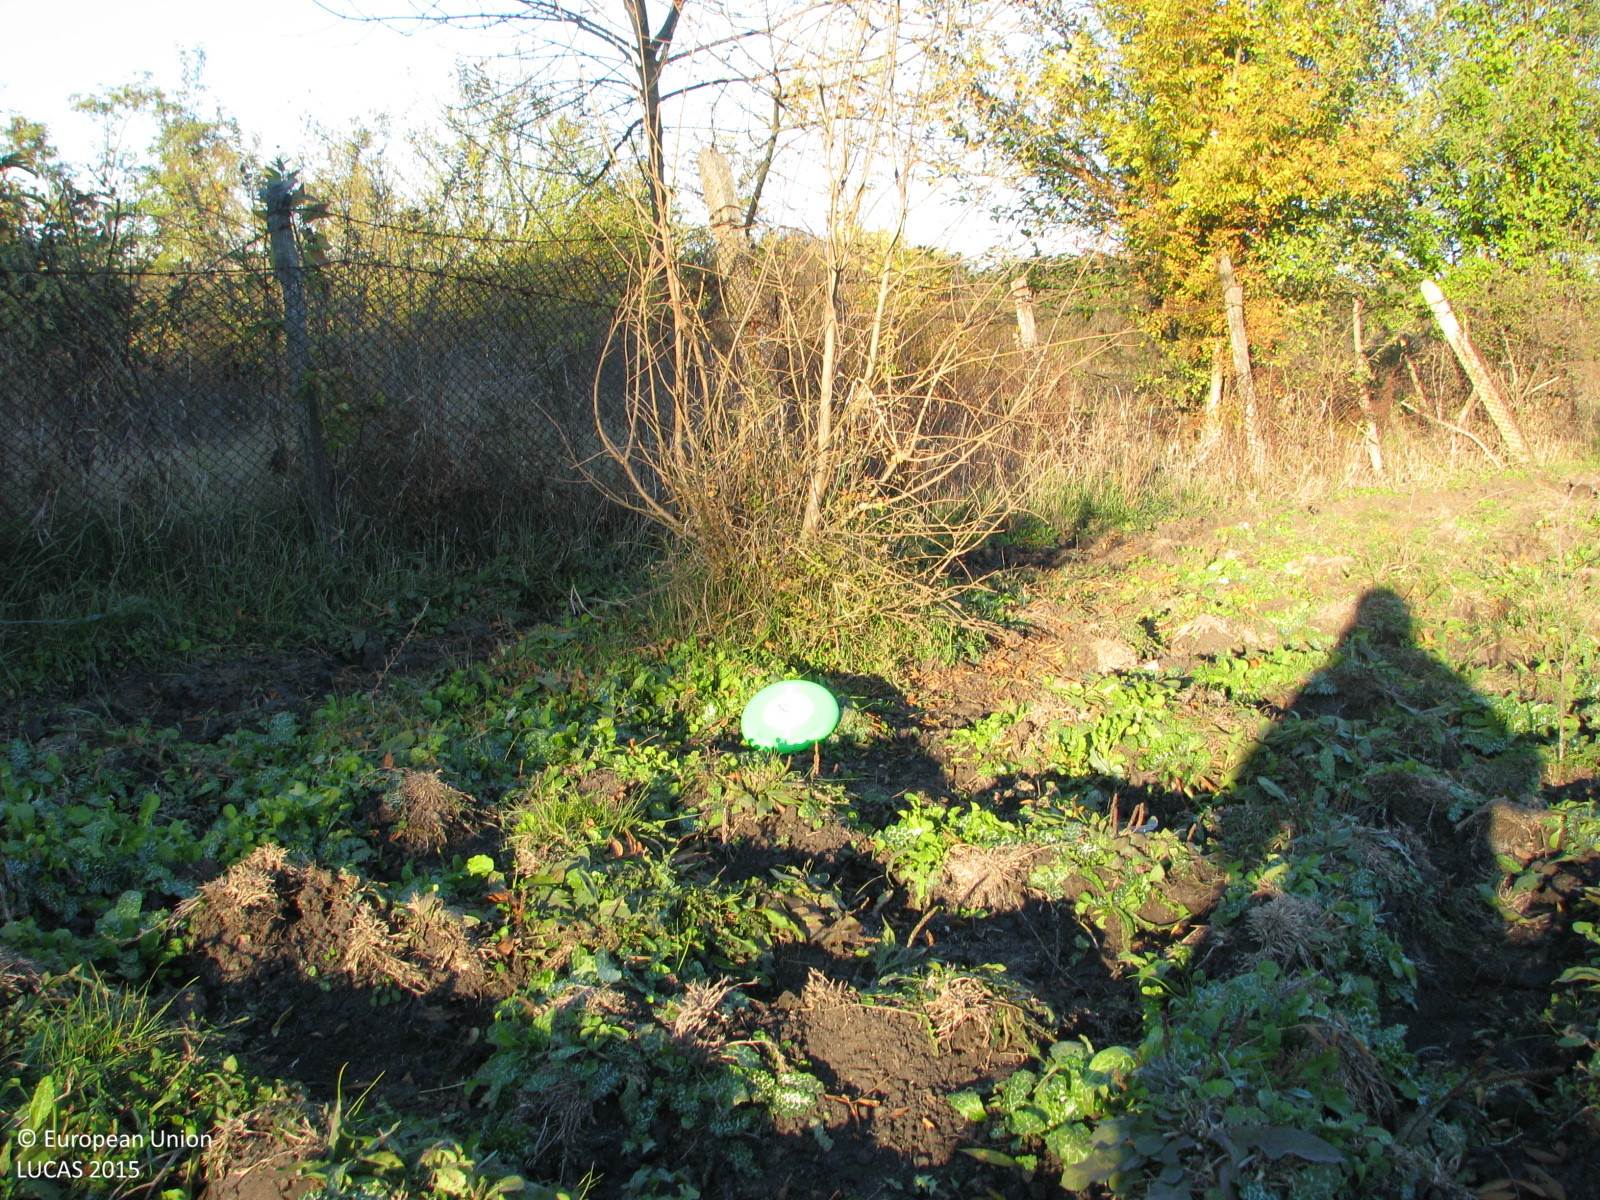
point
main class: Grassland
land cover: Spontaneously vegetated surfaces
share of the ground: > 75 %
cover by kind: herbaceous plants 95 %, consolidated bare surface 5 %
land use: Agriculture (excluding fallow land and kitchen gardens)
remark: Harvested field
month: November
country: BG
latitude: 42.1210
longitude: 26.6995
